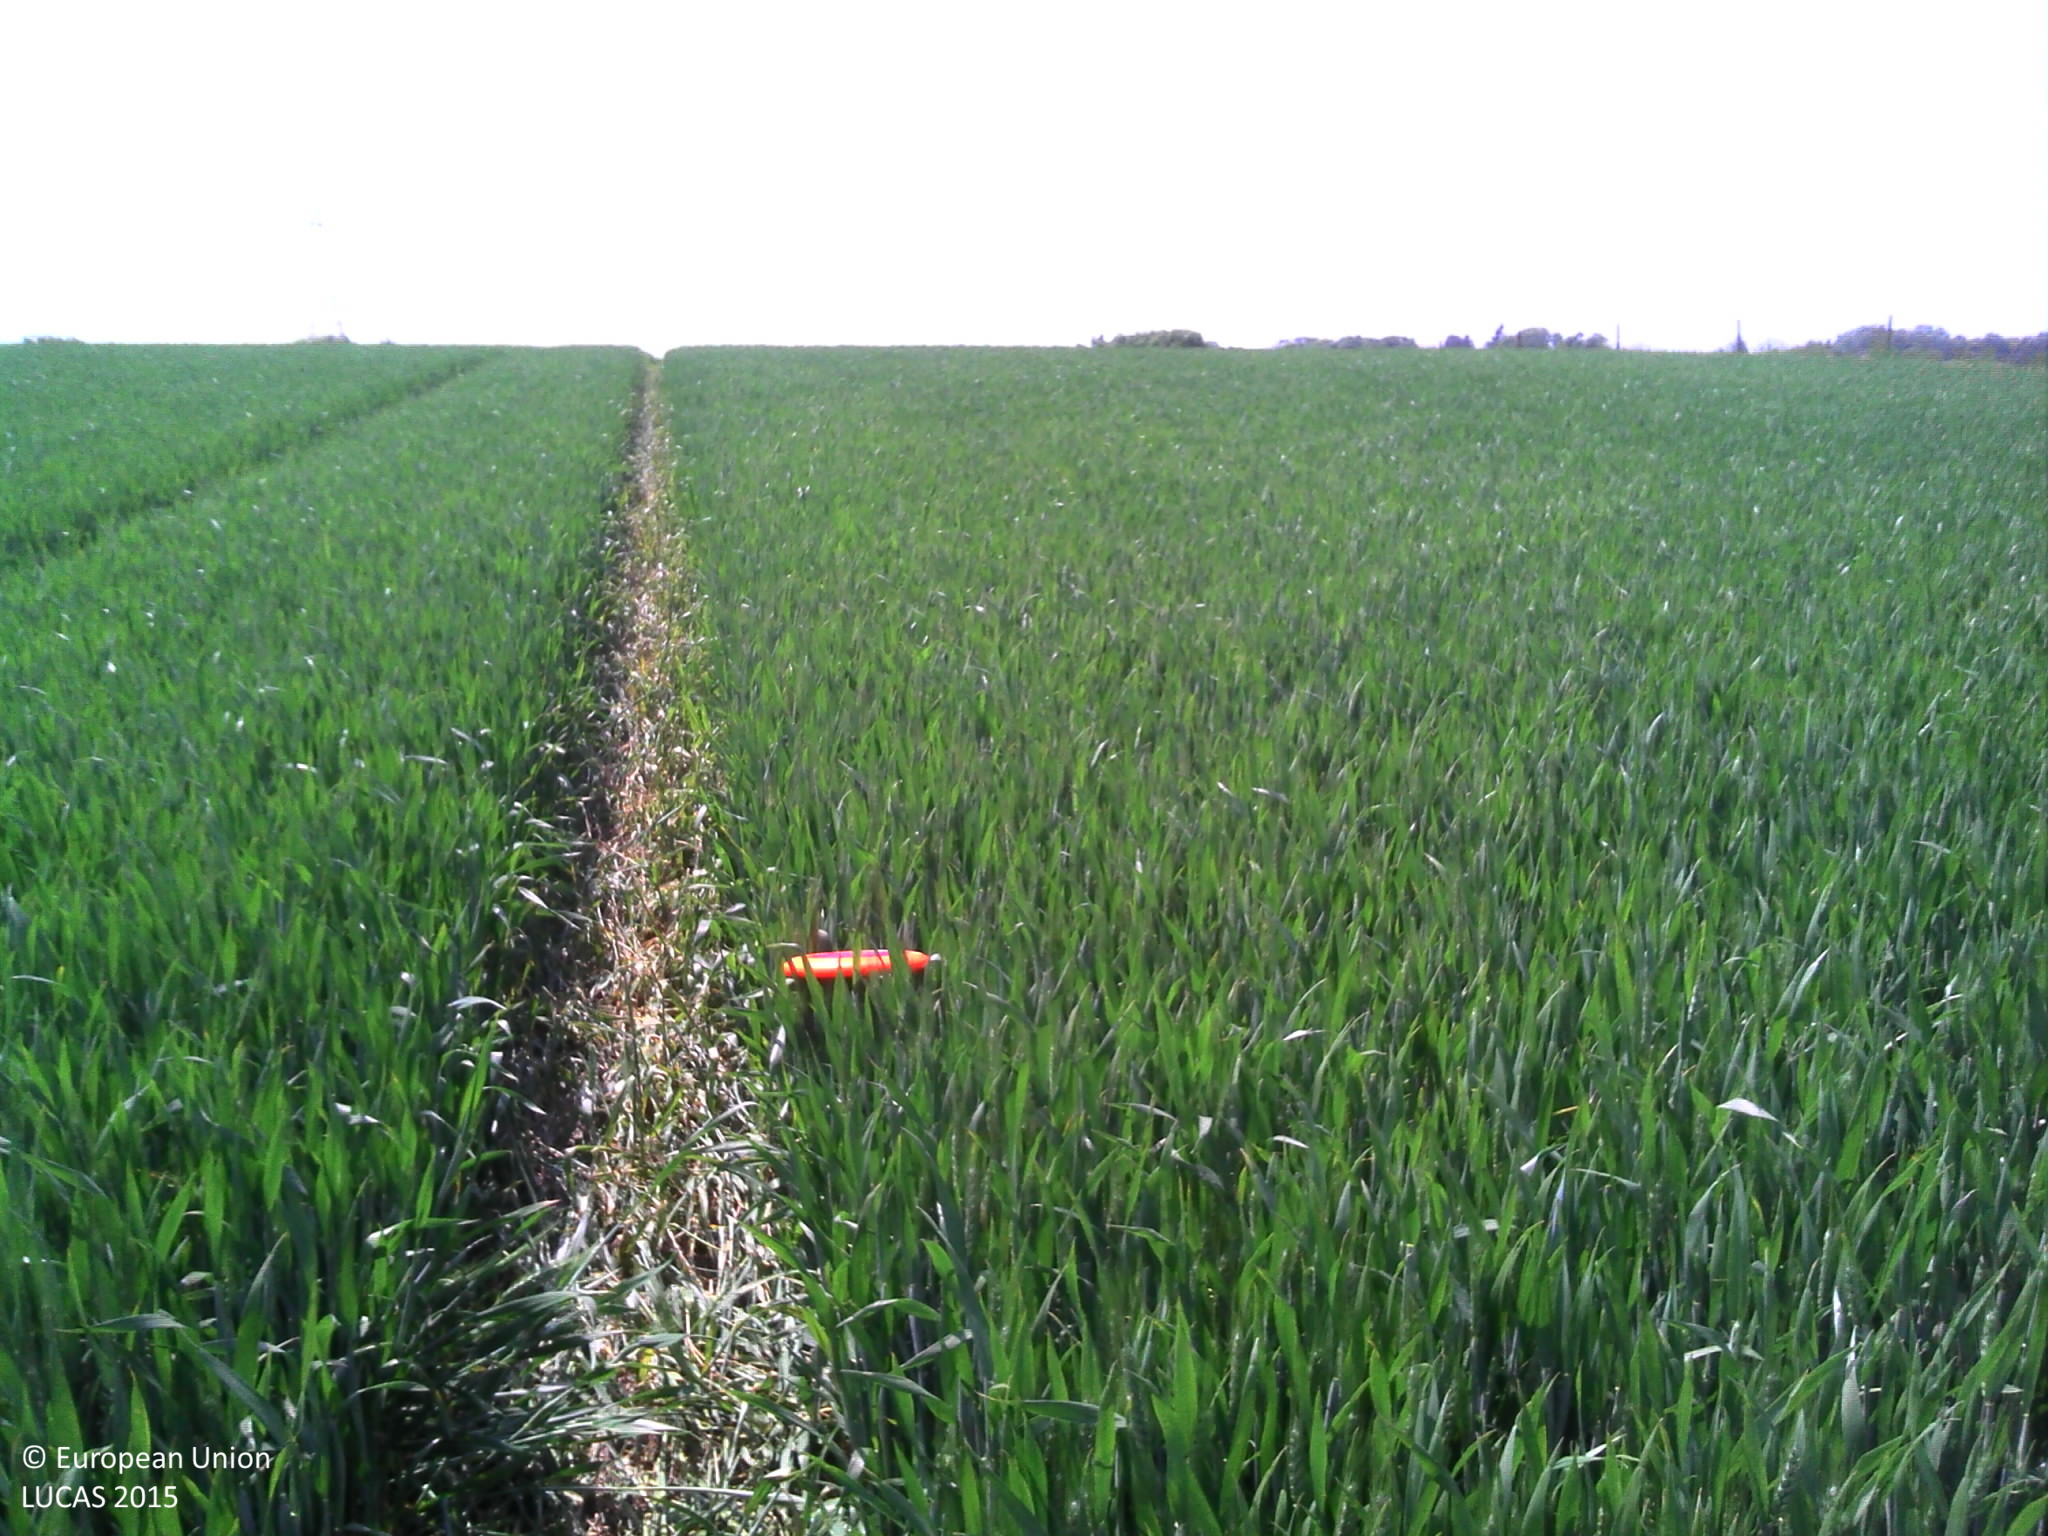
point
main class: Cropland
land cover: Common wheat
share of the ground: > 75 %
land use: Agriculture (excluding fallow land and kitchen gardens)
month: May
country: BE
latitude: 50.6142
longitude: 4.5833
